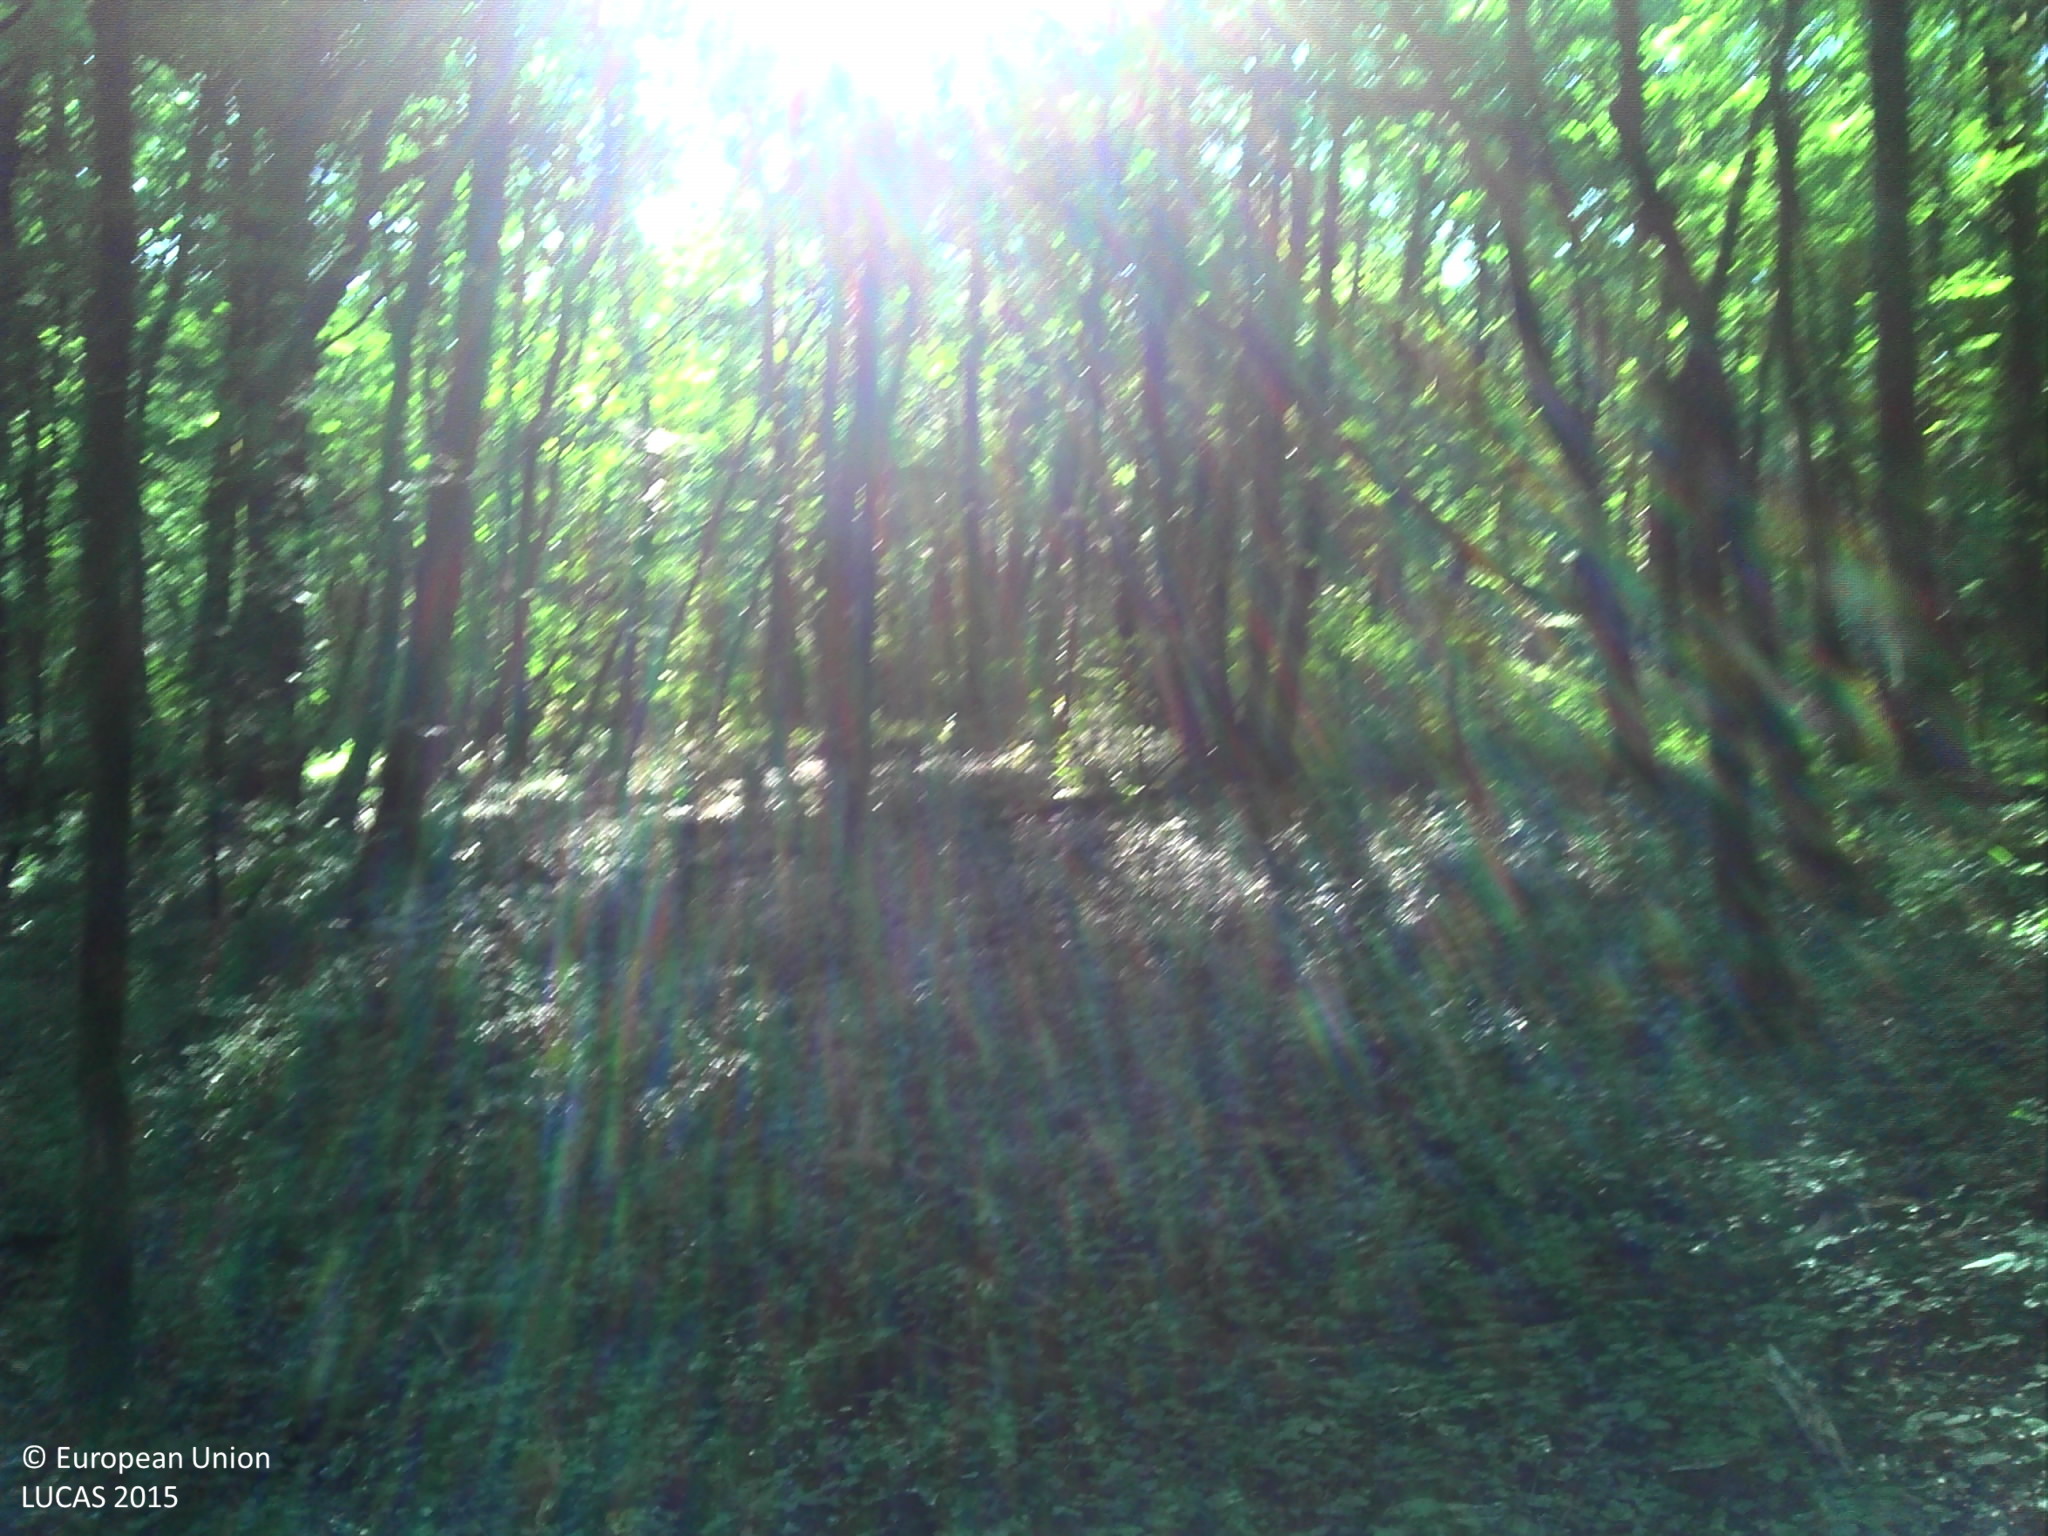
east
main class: Woodland
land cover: Broadleaved woodland
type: beech forest
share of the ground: > 75 %
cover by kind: broadleaved forest trees 95 %, herbaceous plants 5 %
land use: Forestry
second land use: Sport
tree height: > 5 m
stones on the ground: < 10 %
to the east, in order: Broadleaved woodland; Dry stone walls; Broadleaved woodland; Dry stone walls; Broadleaved woodland; Dry stone walls; Broadleaved woodland
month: June
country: FR
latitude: 47.5981
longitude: 6.1576
